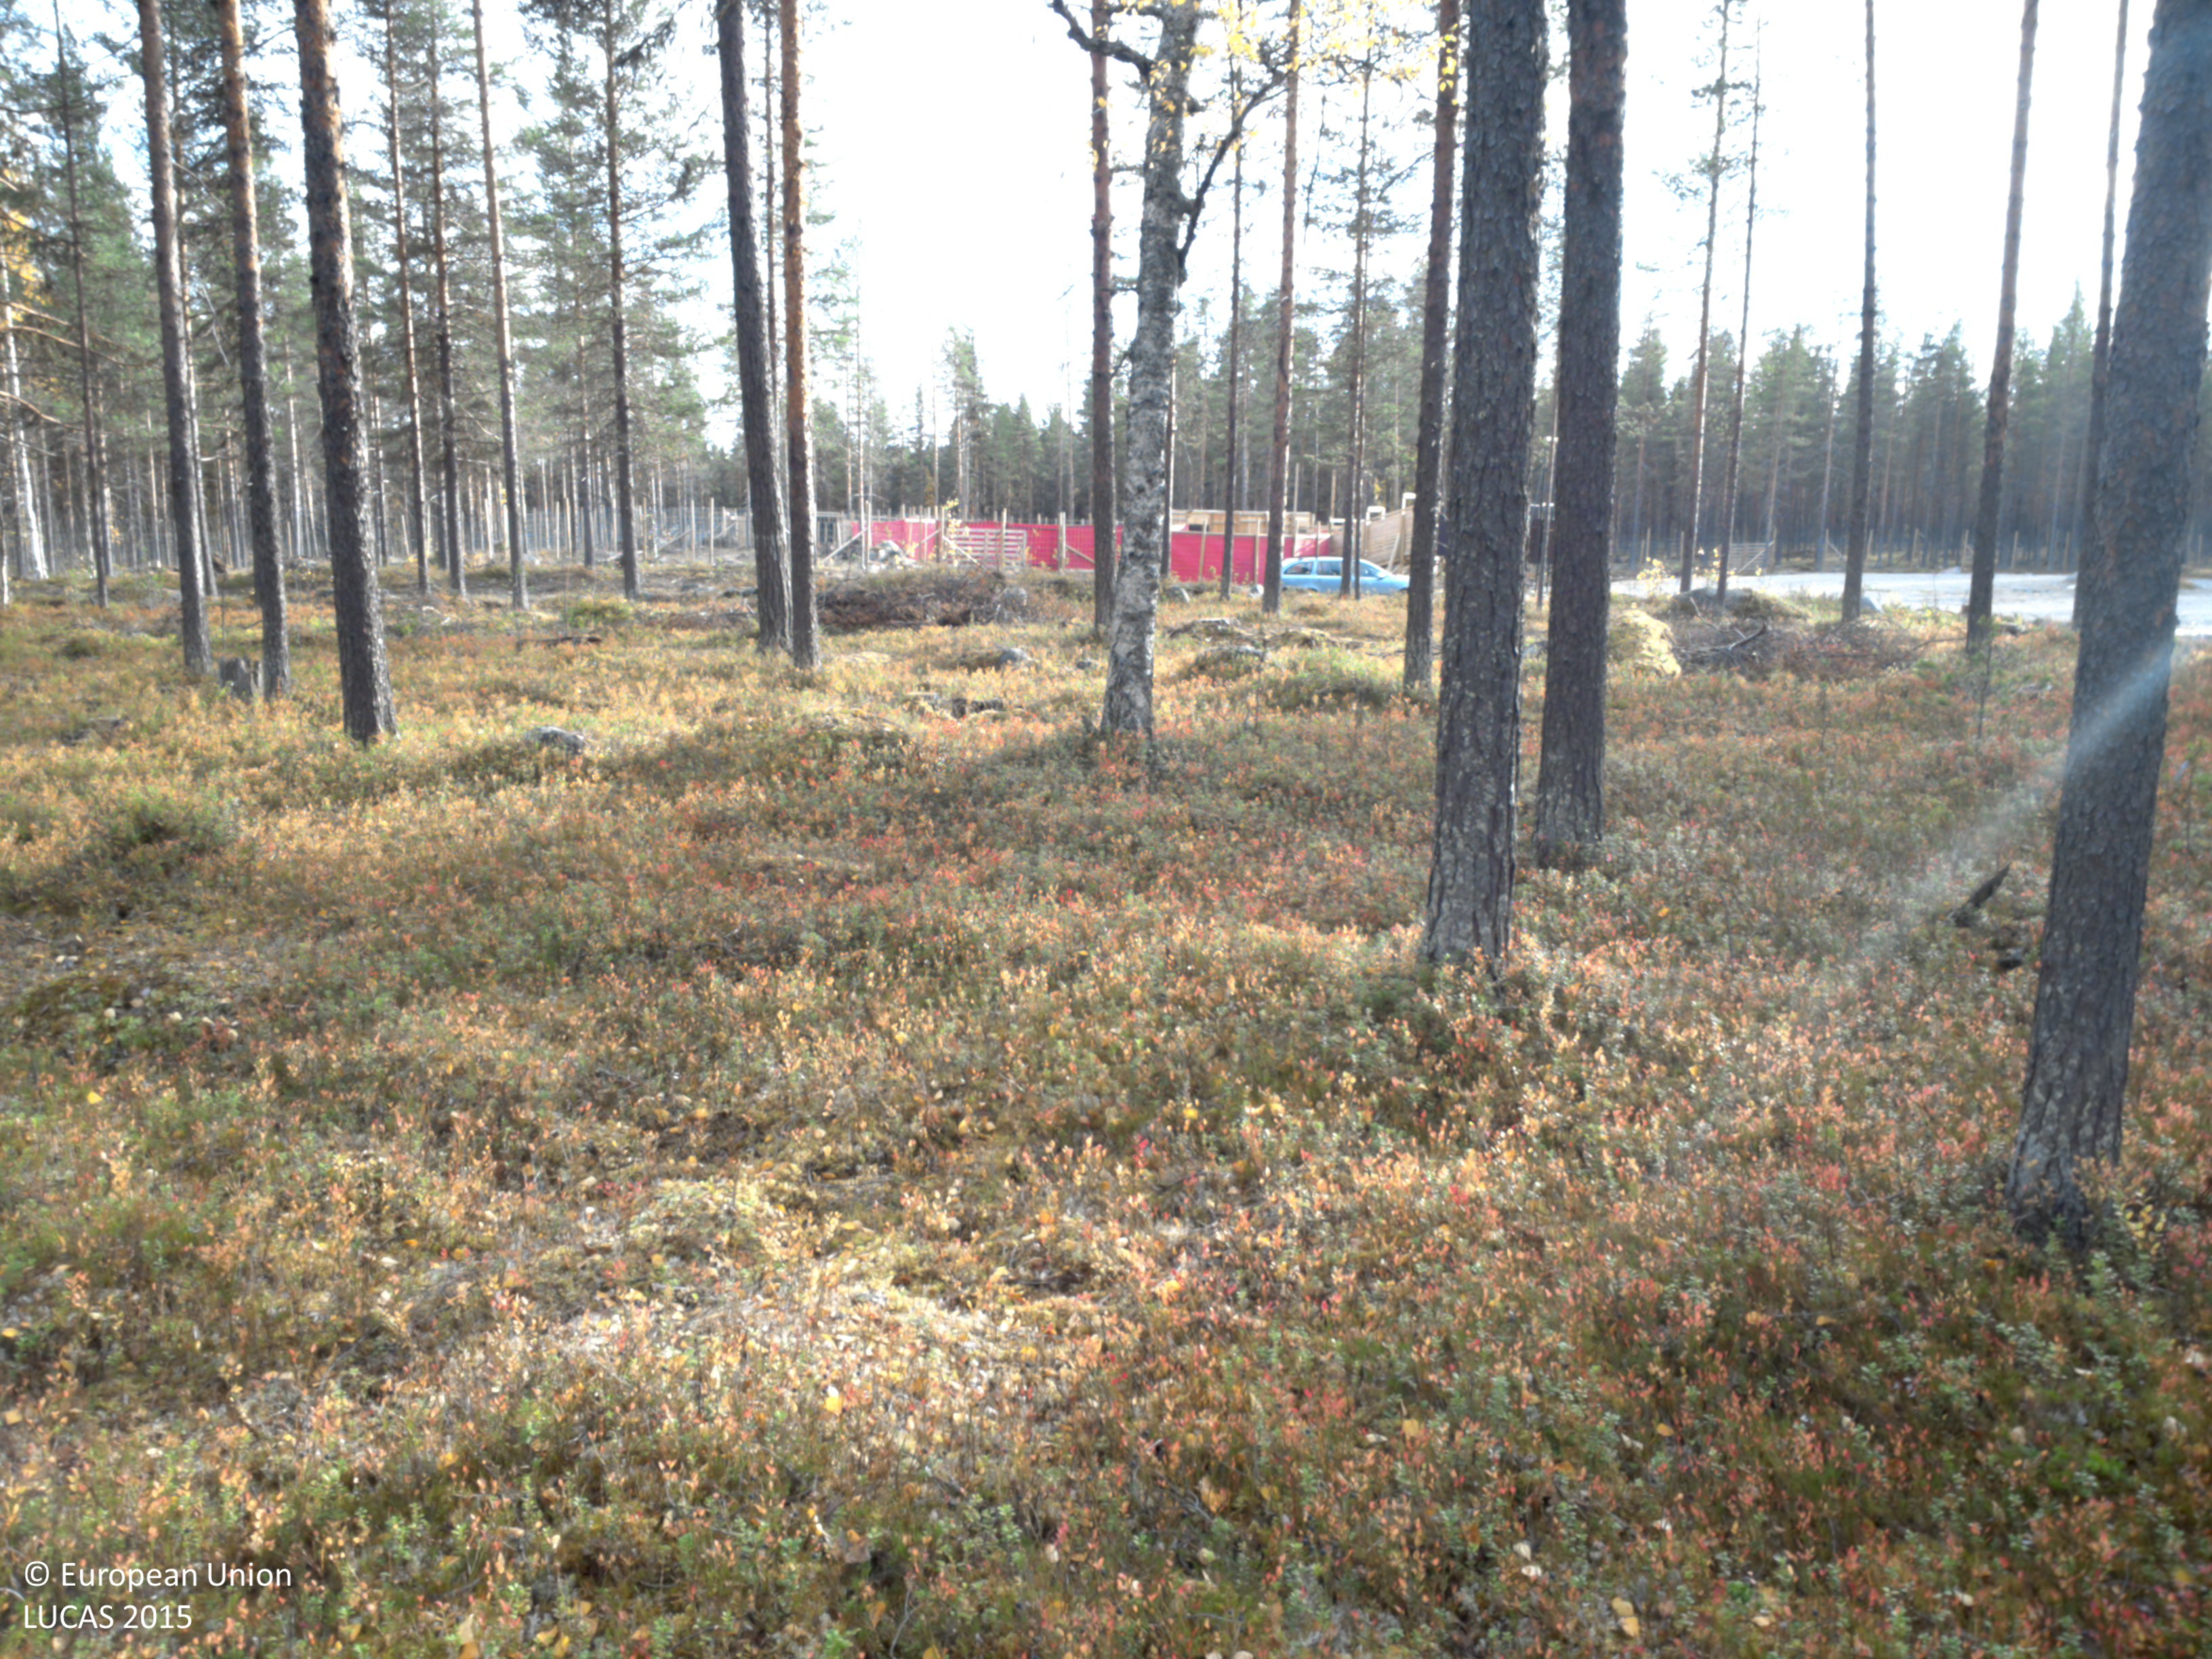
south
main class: Woodland
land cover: Pine dominated coniferous woodland
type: boreal forest
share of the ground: > 75 %
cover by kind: coniferous forest trees 55 %, shrubs 30 %, lichens and mosses 5 %, consolidated bare surface 5 %
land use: Forestry
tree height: > 5 m
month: September
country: SE
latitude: 64.8964
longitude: 18.5207
